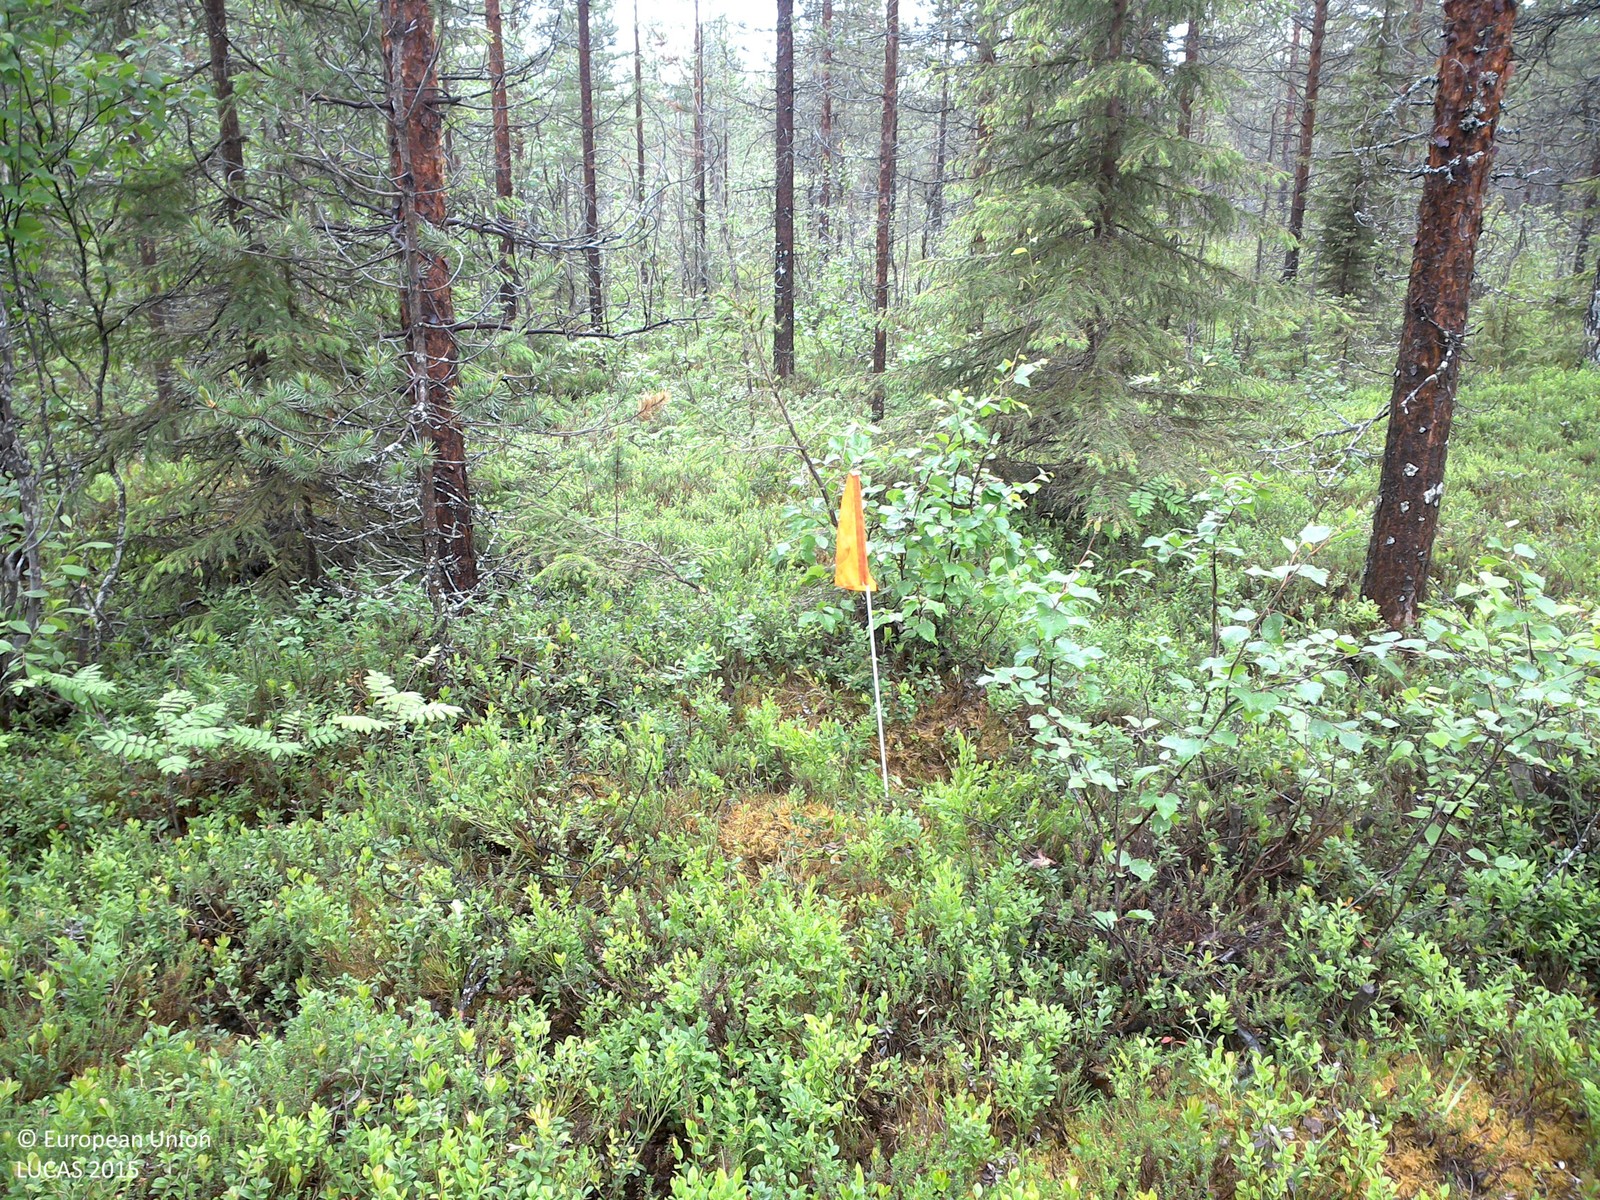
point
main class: Woodland
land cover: Pine dominated mixed woodland
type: boreal forest
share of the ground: 25 - 50 %
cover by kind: shrubs 65 %, coniferous forest trees 25 %, broadleaved forest trees 10 %
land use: Forestry
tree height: > 5 m
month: July
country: SE
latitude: 67.0887
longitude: 23.5804
